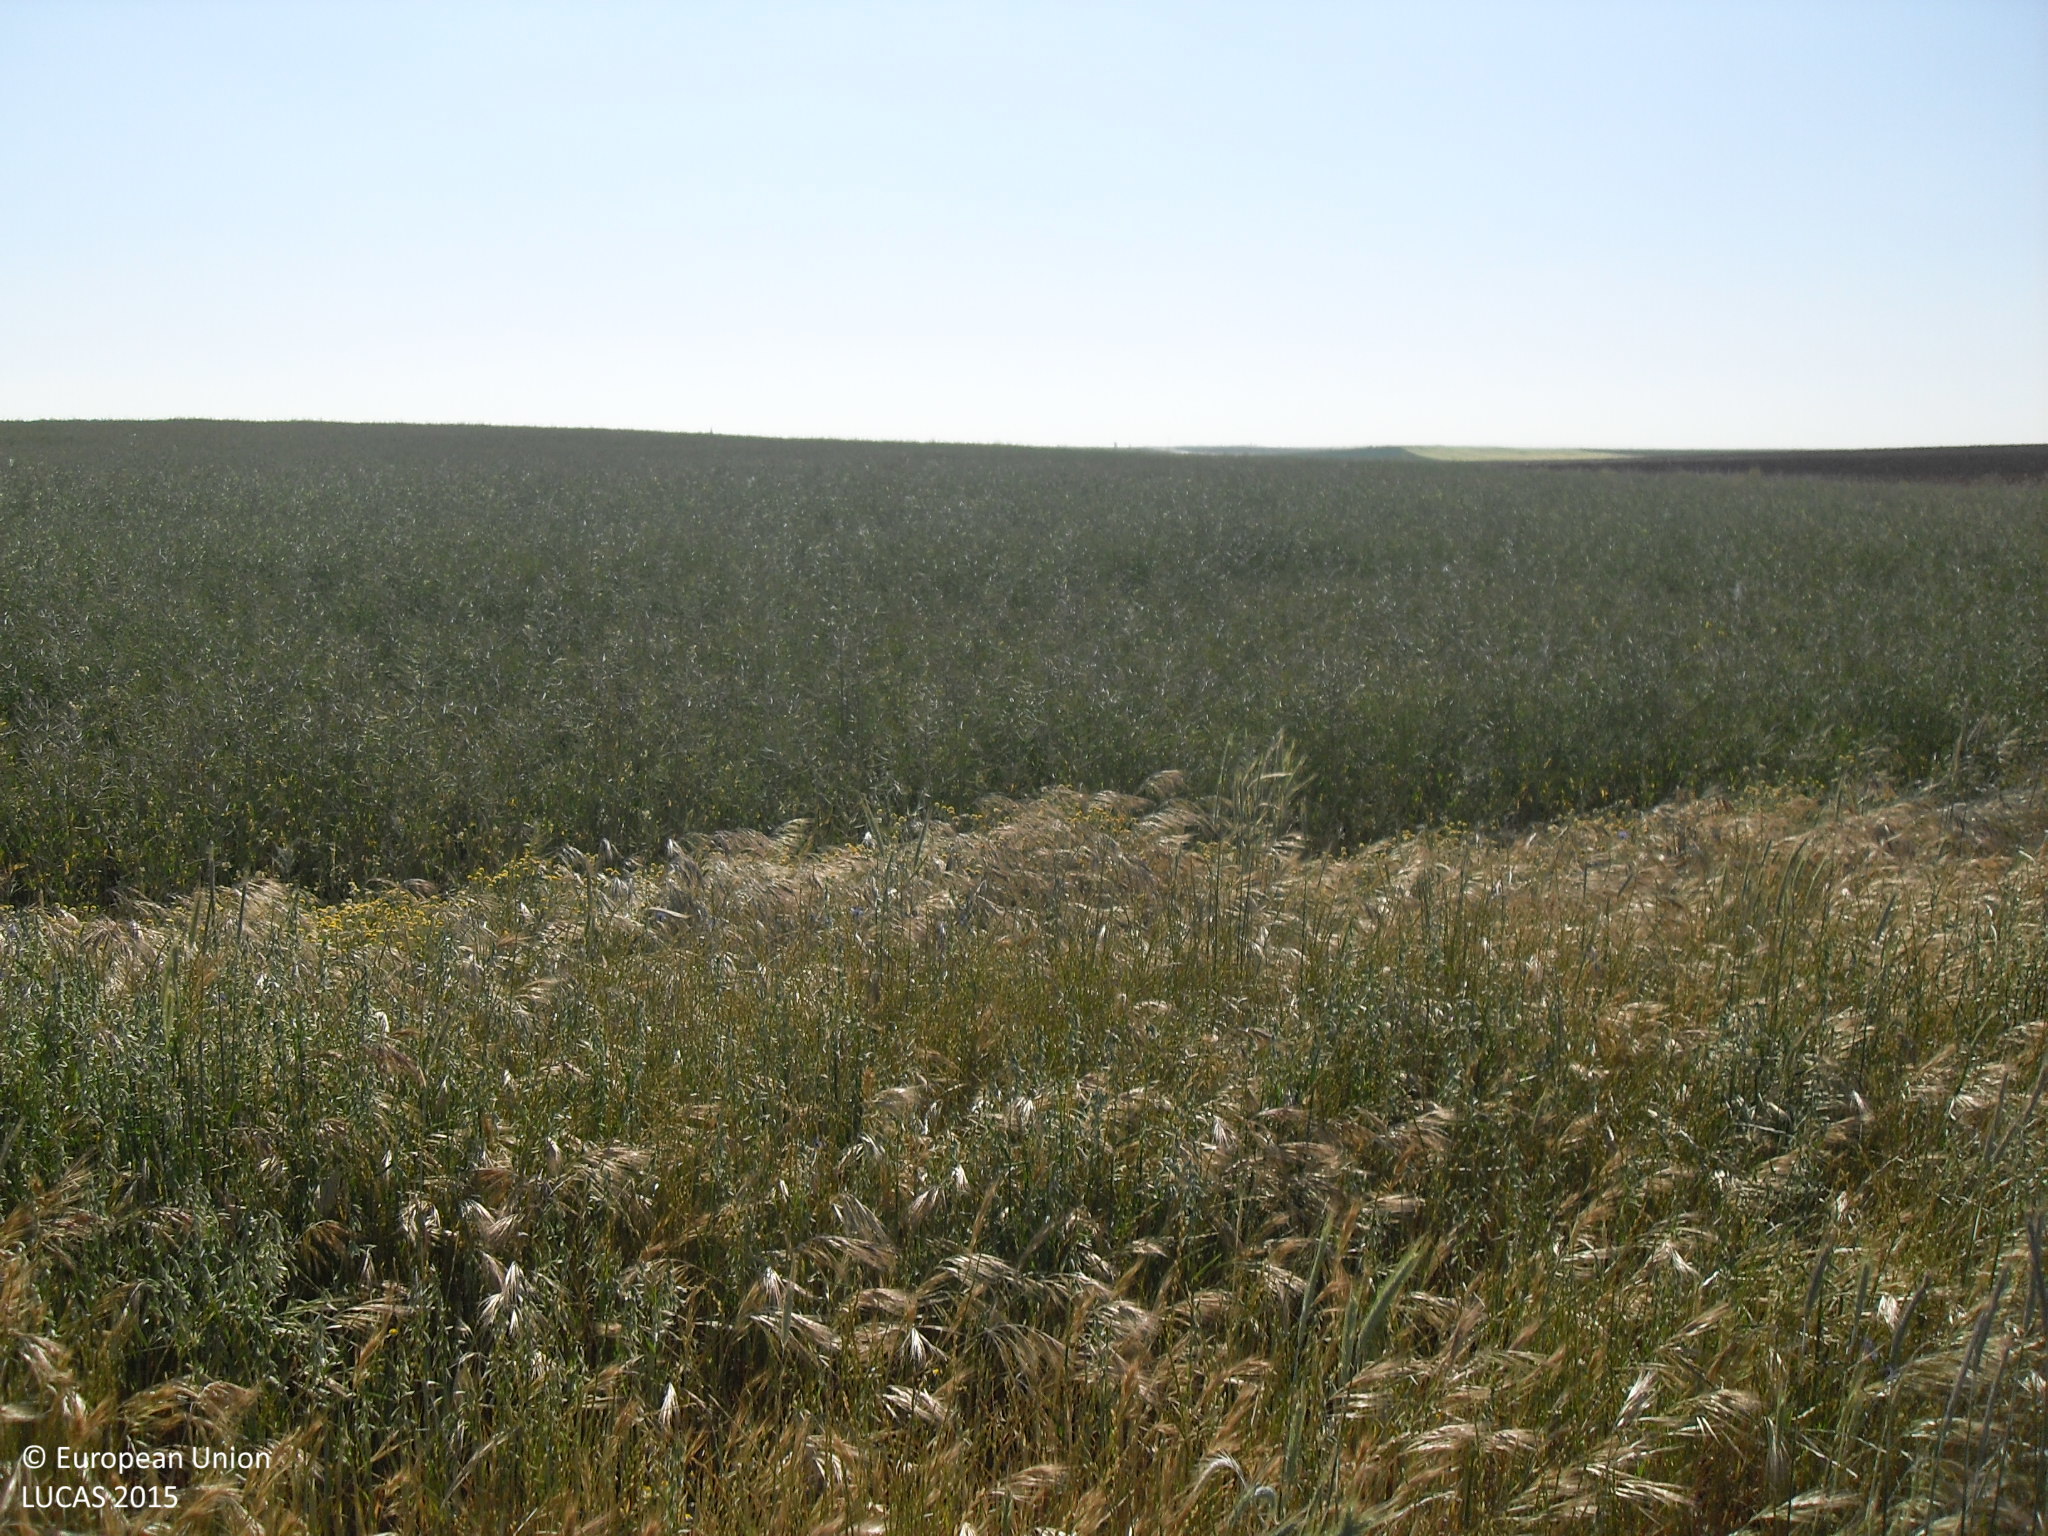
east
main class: Cropland
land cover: Oats
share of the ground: > 75 %
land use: Agriculture (excluding fallow land and kitchen gardens)
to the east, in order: Oats; Grass margins; Rape and turnip rape
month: May
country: ES
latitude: 41.0524
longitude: -5.2403
